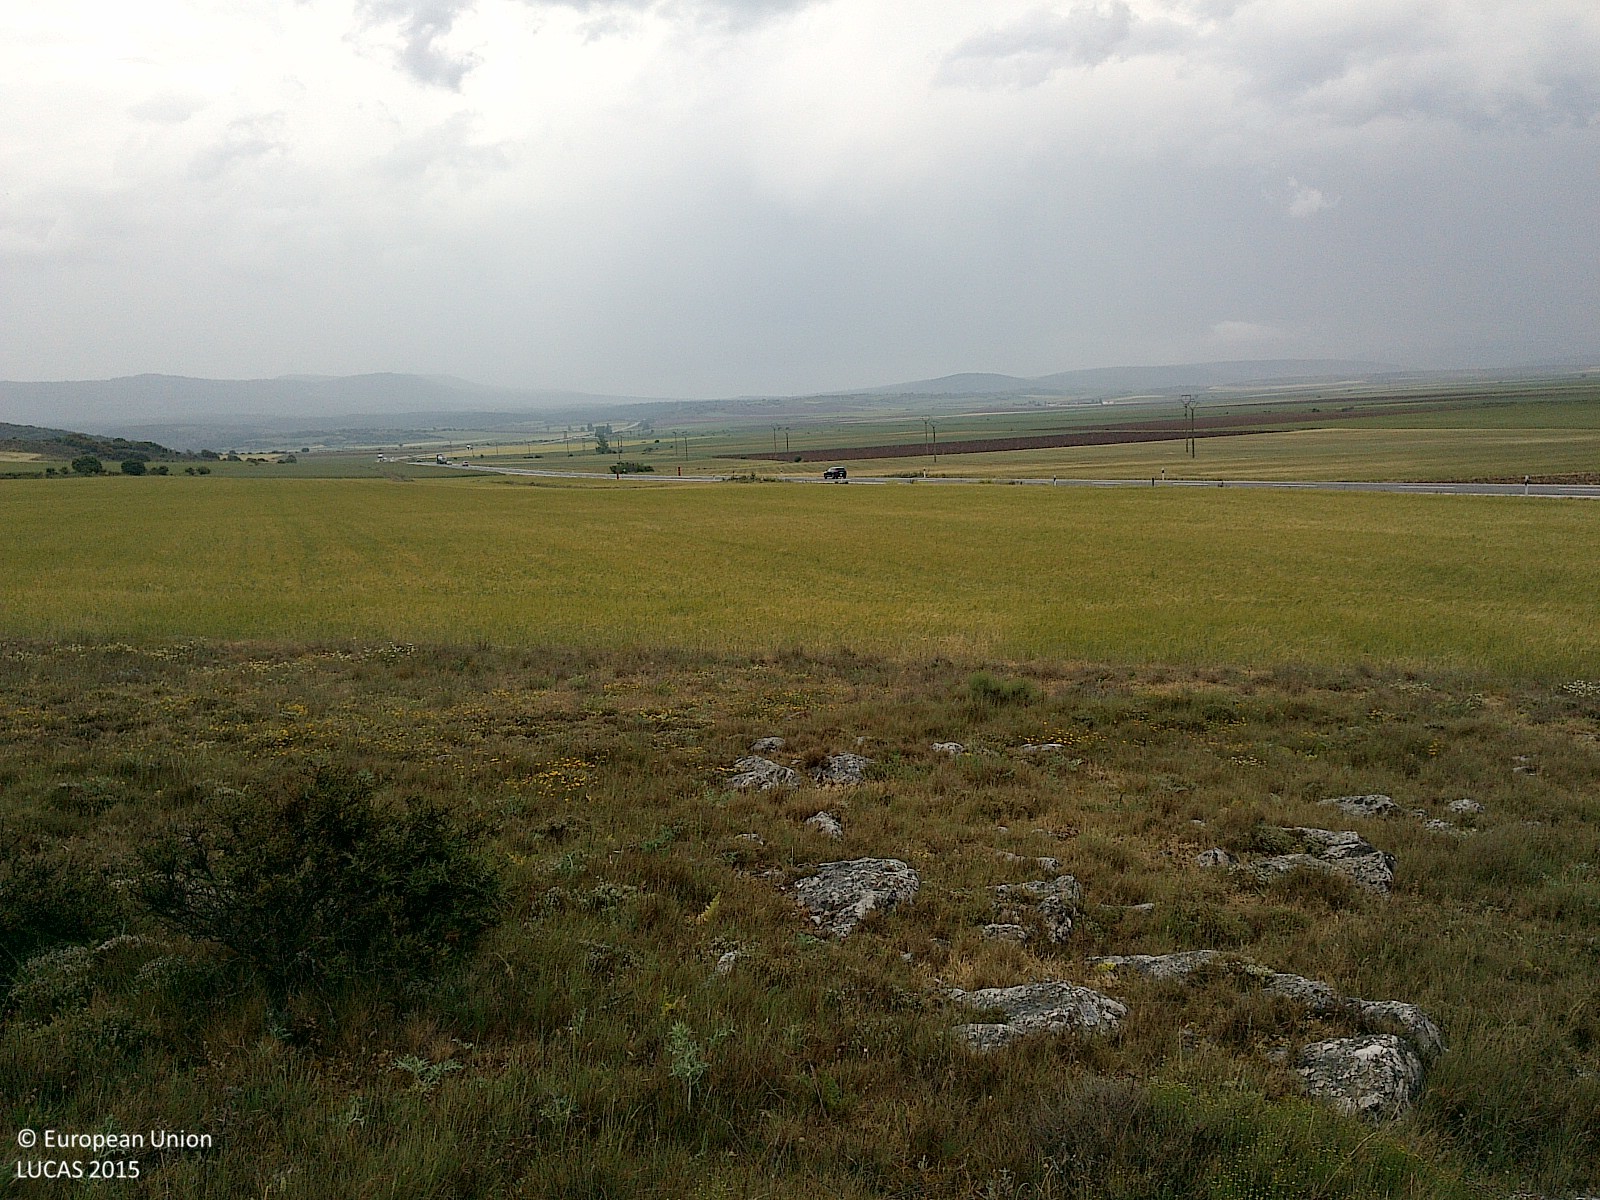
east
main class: Grassland
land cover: Grassland without tree/shrub cover
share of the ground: > 75 %
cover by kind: herbaceous plants 85 %, consolidated bare surface 10 %, shrubs 5 %
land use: Semi-natural and natural areas not in use
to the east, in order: Grassland without tree/shrub cover; Barley; Grass margins; Paved roads, cycling and walking lanes; Tracks; Grass margins; Barley
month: May
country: ES
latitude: 41.7858
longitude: -2.2001
